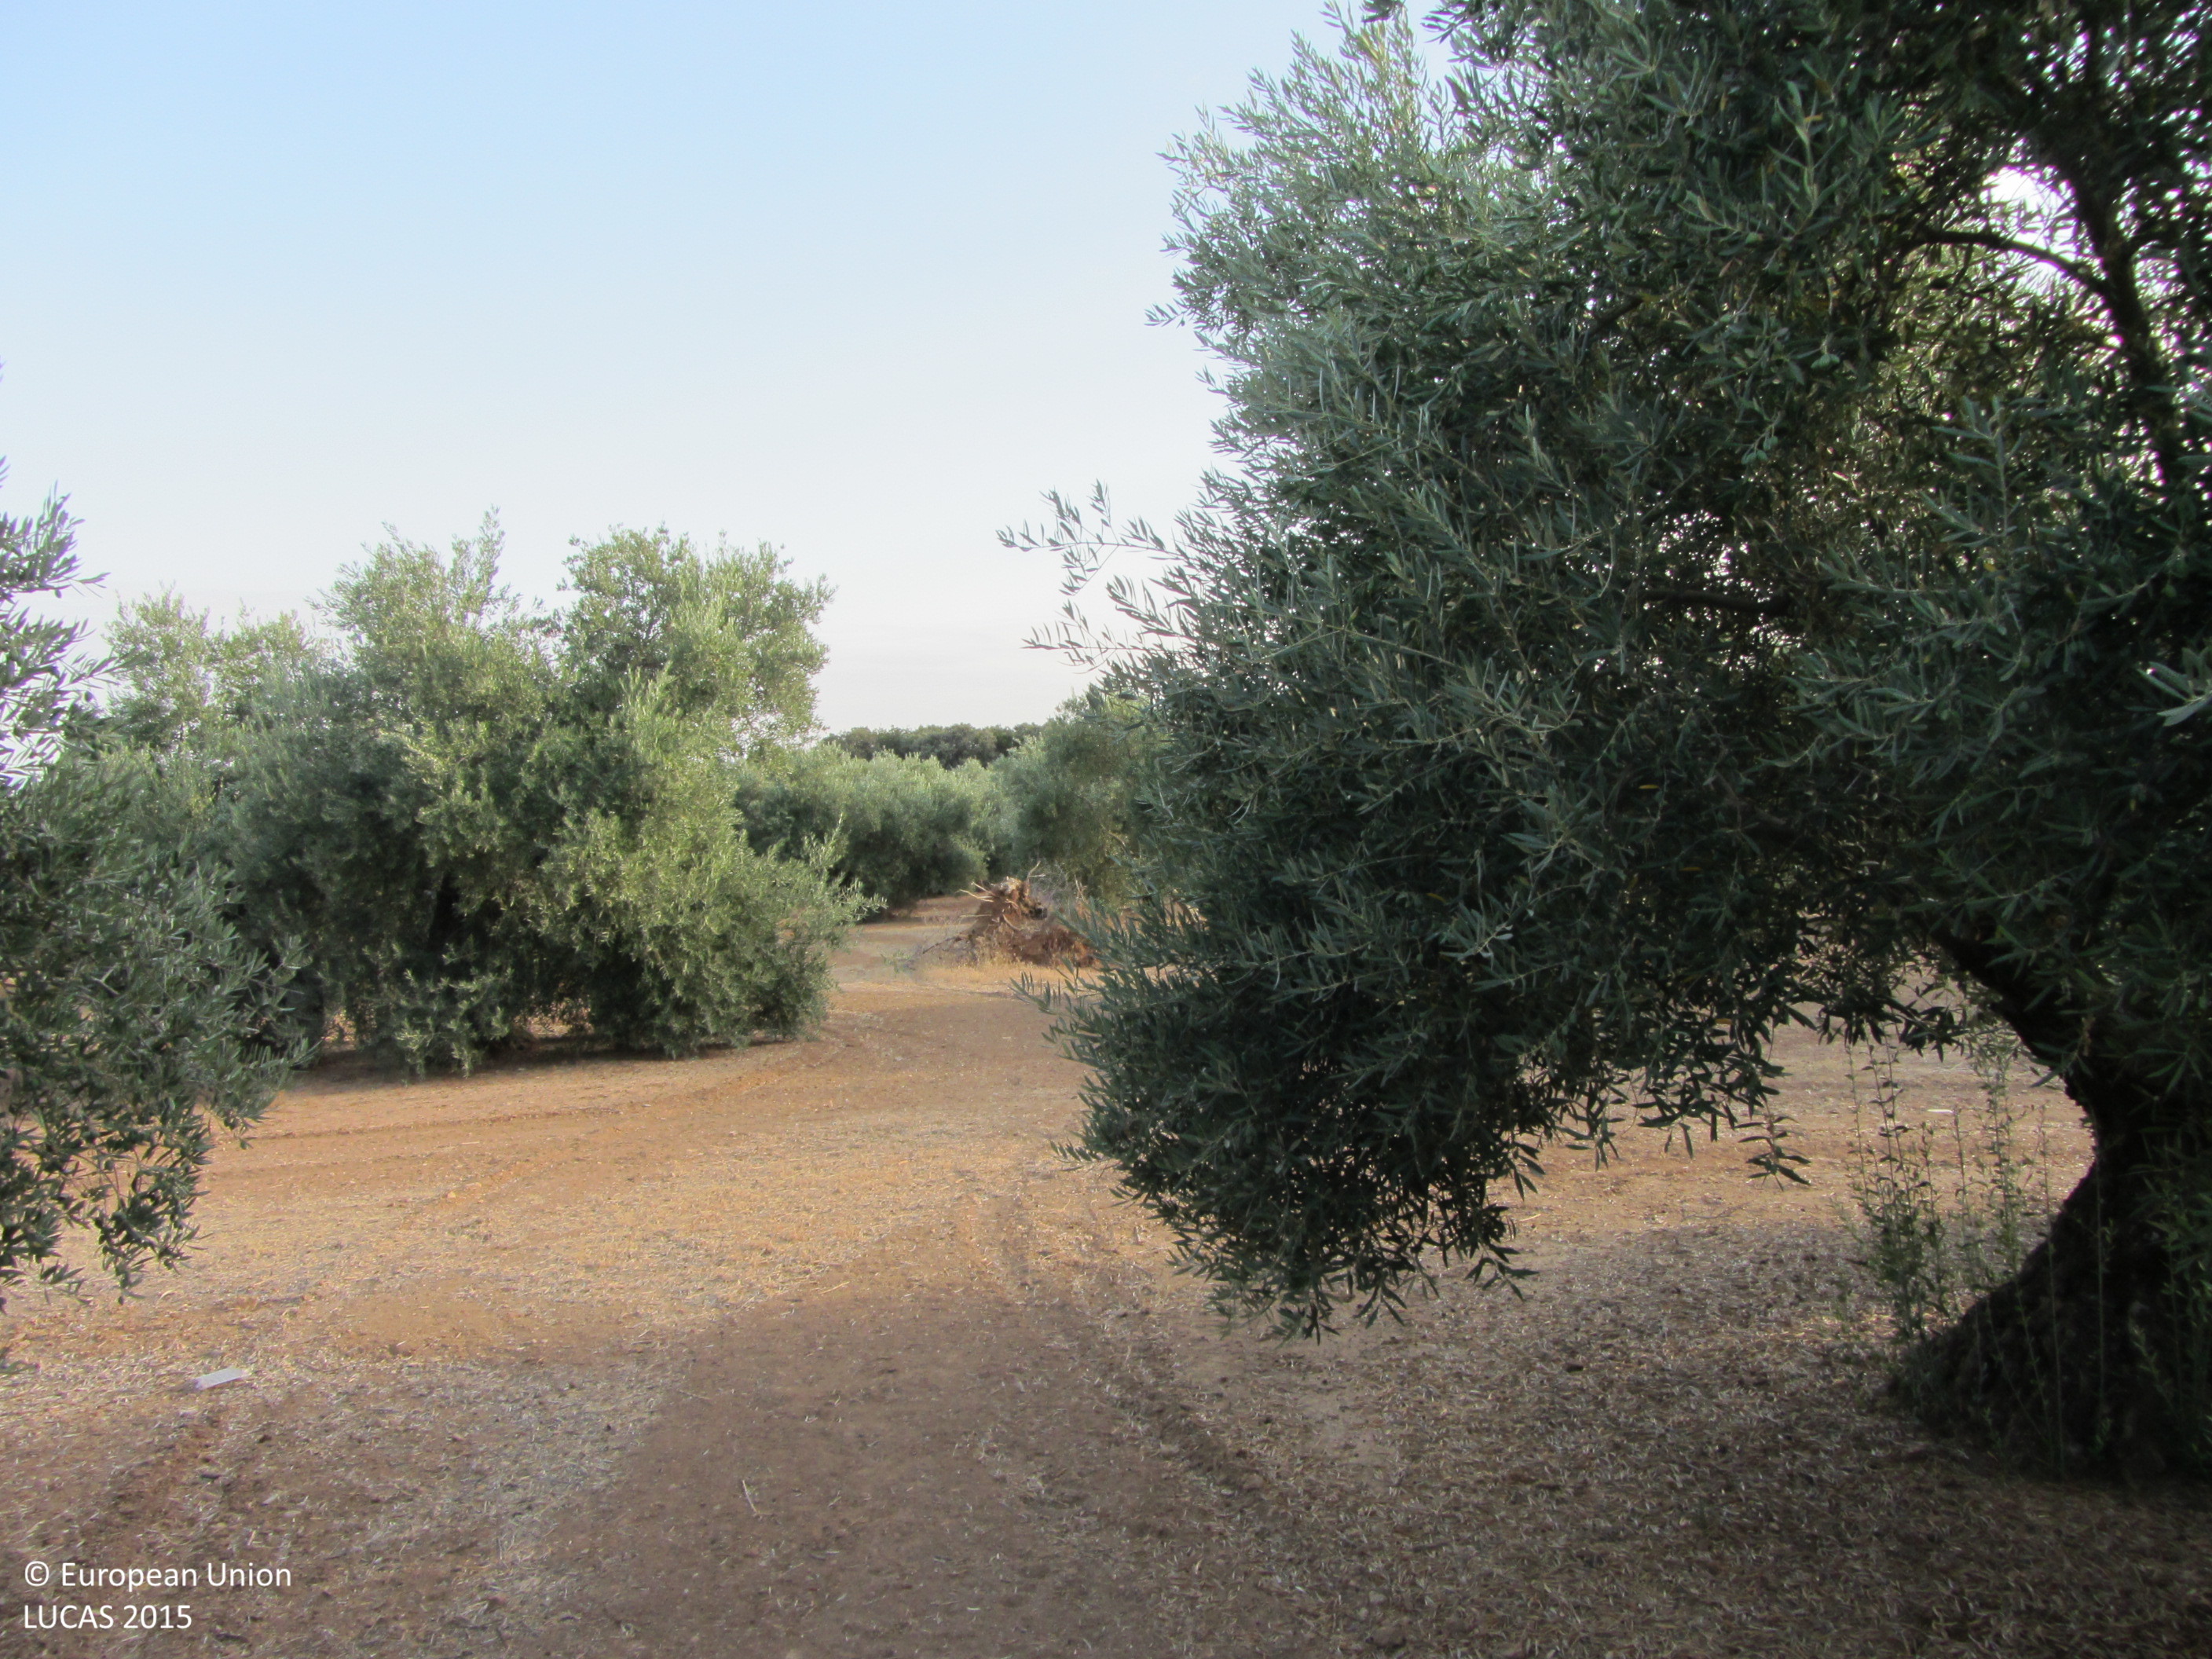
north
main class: Cropland
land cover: Olive groves
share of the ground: 25 - 50 %
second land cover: Other bare soil
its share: > 75 %
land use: Agriculture (excluding fallow land and kitchen gardens)
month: July
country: ES
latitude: 38.0406
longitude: -3.4119
